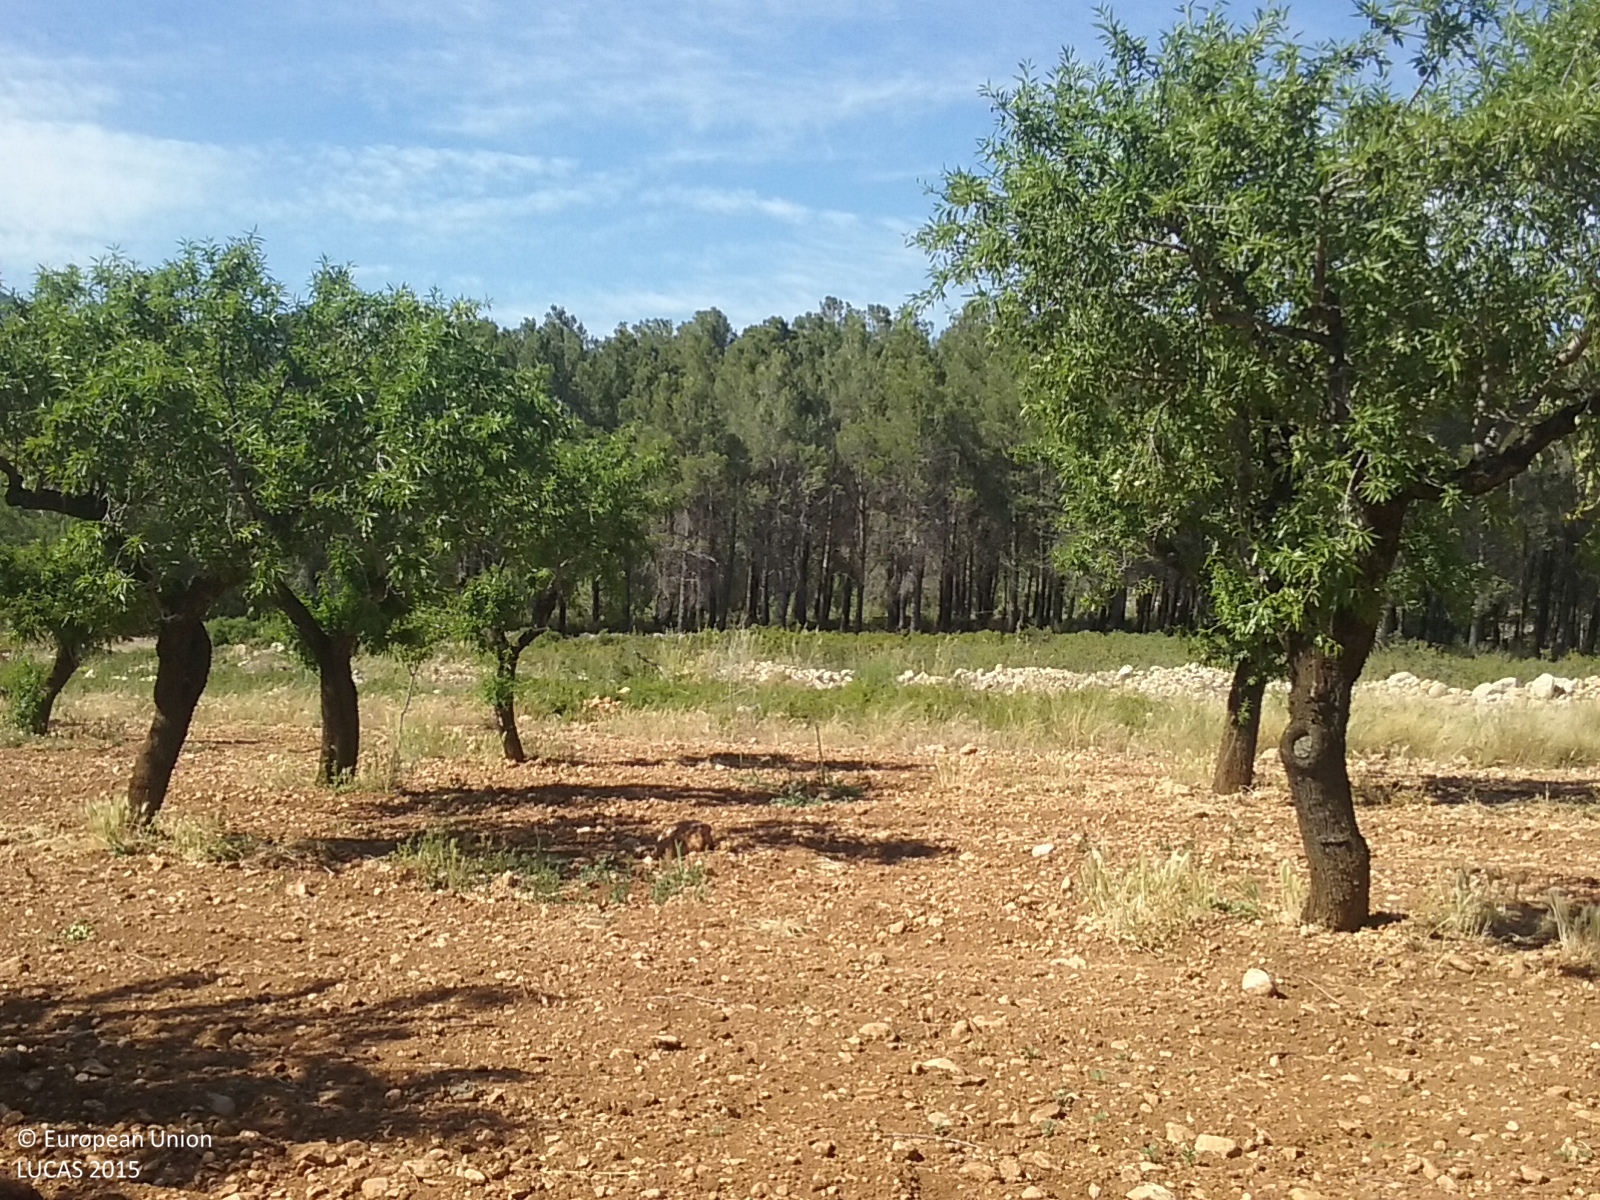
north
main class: Cropland
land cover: Nuts trees
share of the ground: 25 - 50 %
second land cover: Other bare soil
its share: > 75 %
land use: Agriculture (excluding fallow land and kitchen gardens)
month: May
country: ES
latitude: 40.3693
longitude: -0.0505
